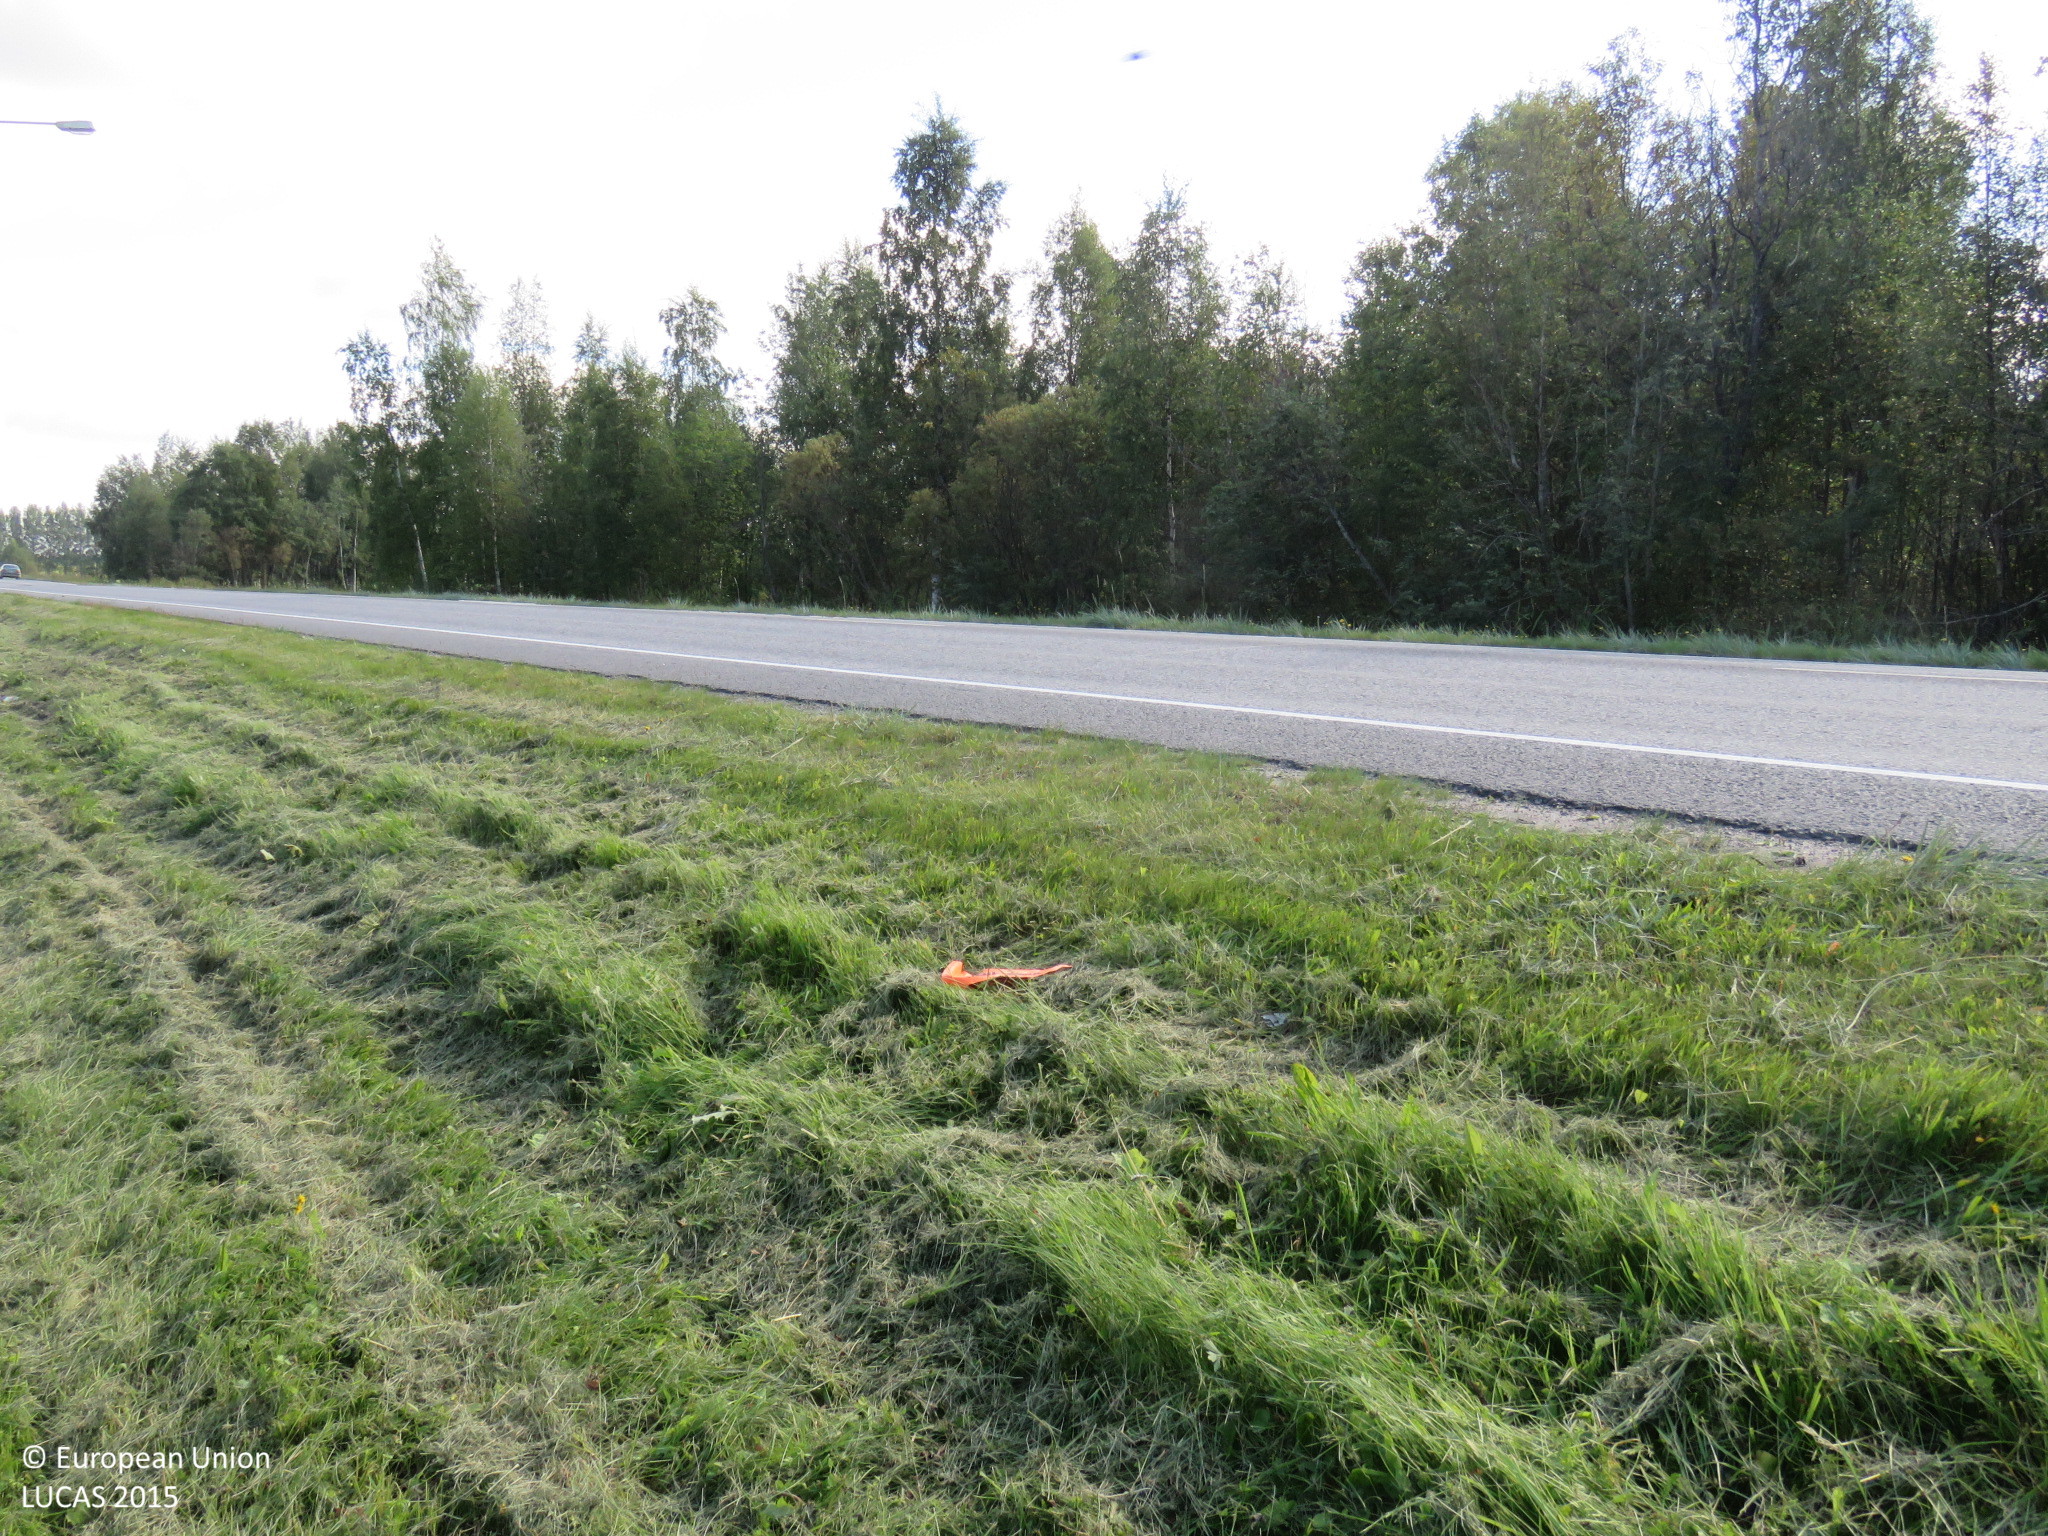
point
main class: Grassland
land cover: Grassland without tree/shrub cover
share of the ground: > 75 %
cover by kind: herbaceous plants 95 %, unconsolidated bare surface 5 %
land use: Road transport
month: August
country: FI
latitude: 64.9457
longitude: 25.4698
